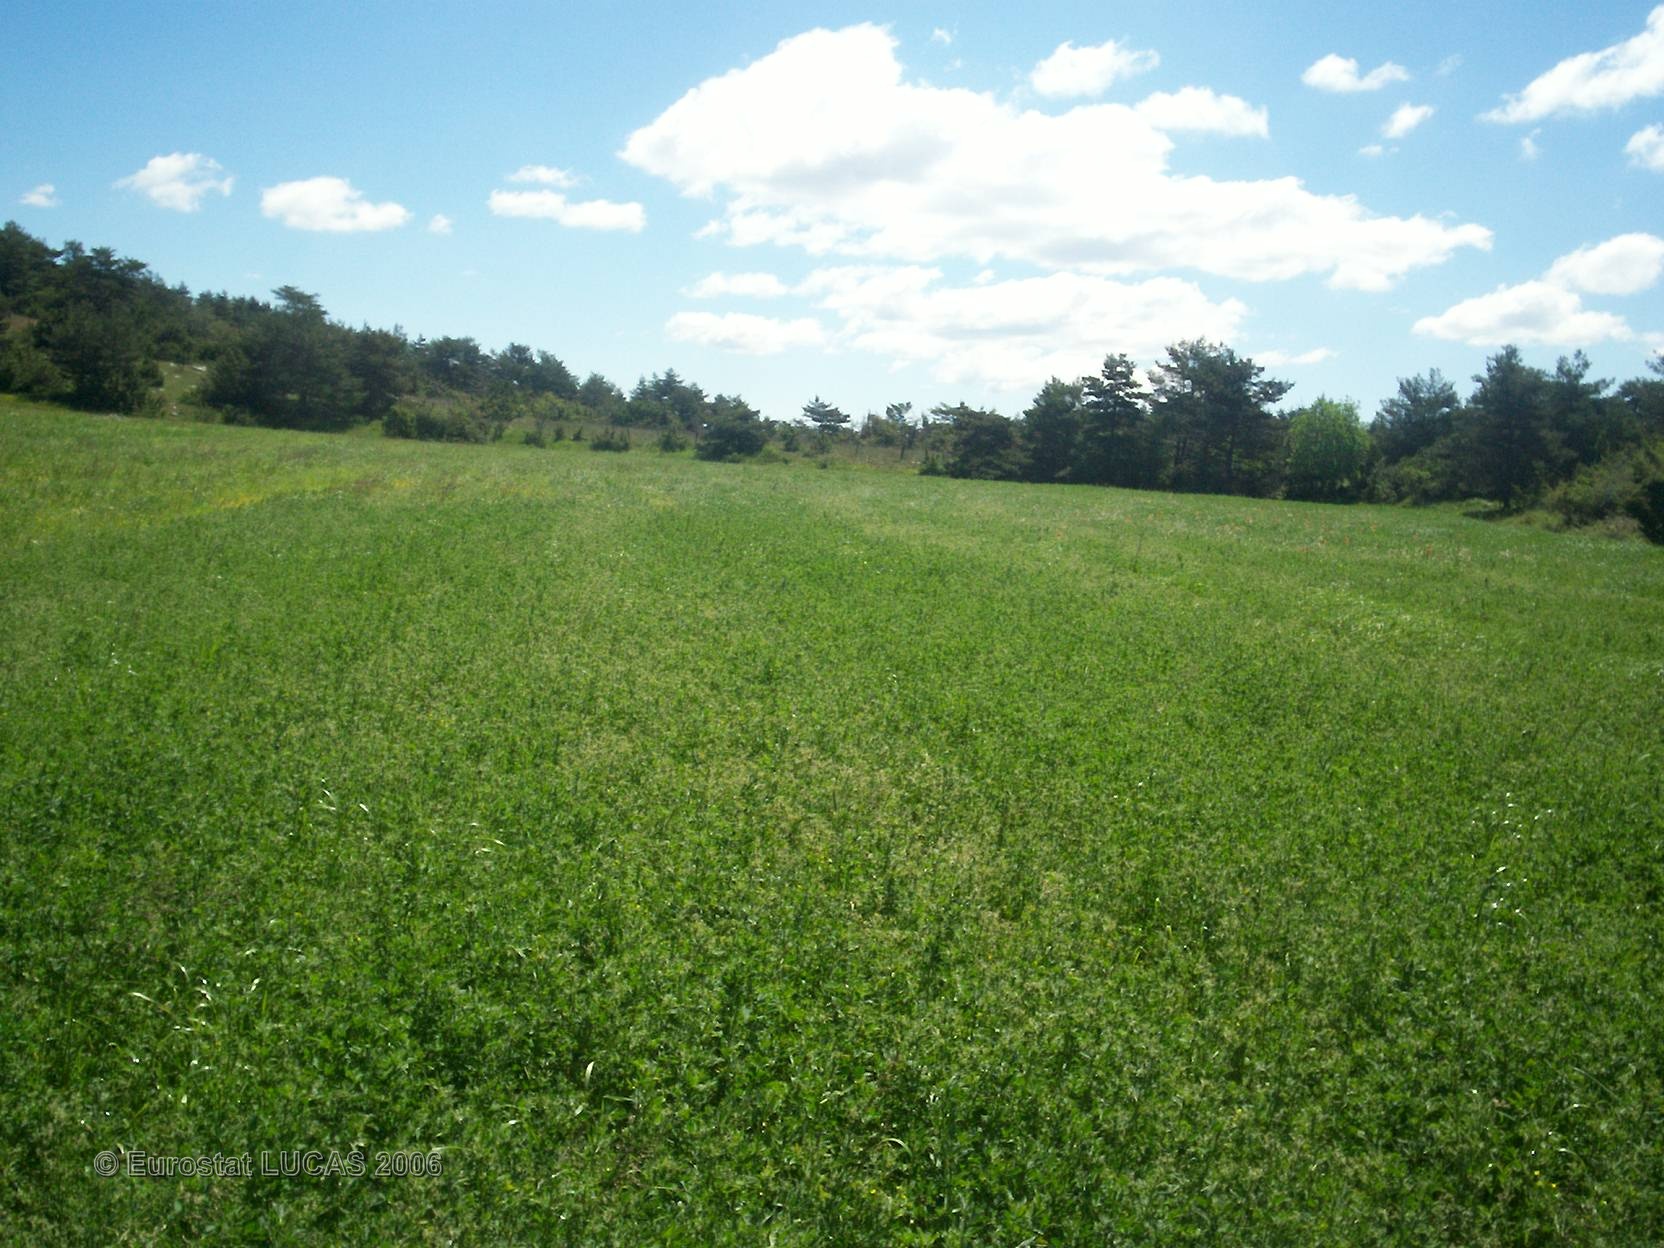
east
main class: Cropland
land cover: Other leguminous and mixtures for fodder
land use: Agriculture (excluding fallow land and kitchen gardens)
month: June
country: FR
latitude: 44.4077
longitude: 3.3374
